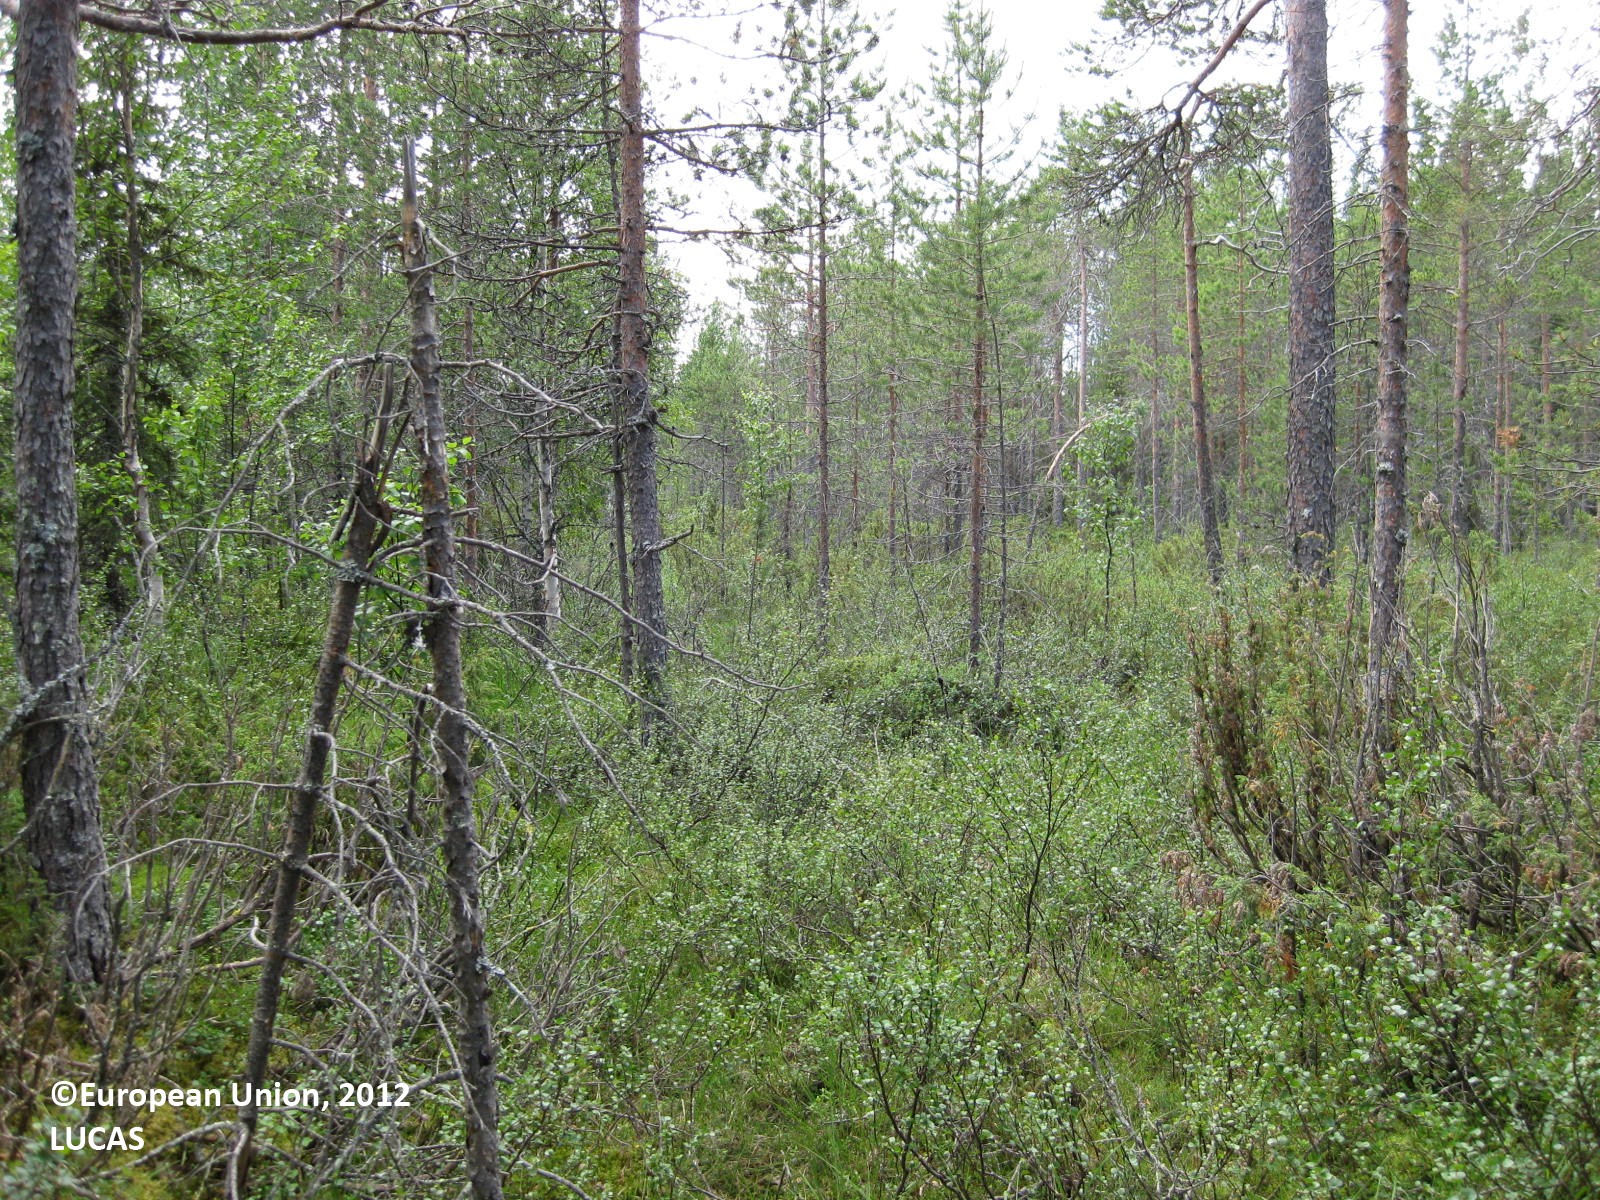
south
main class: Woodland
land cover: Pine dominated mixed woodland
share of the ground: > 75 %
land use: Forestry
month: July
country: FI
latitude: 65.6678
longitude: 29.3073
